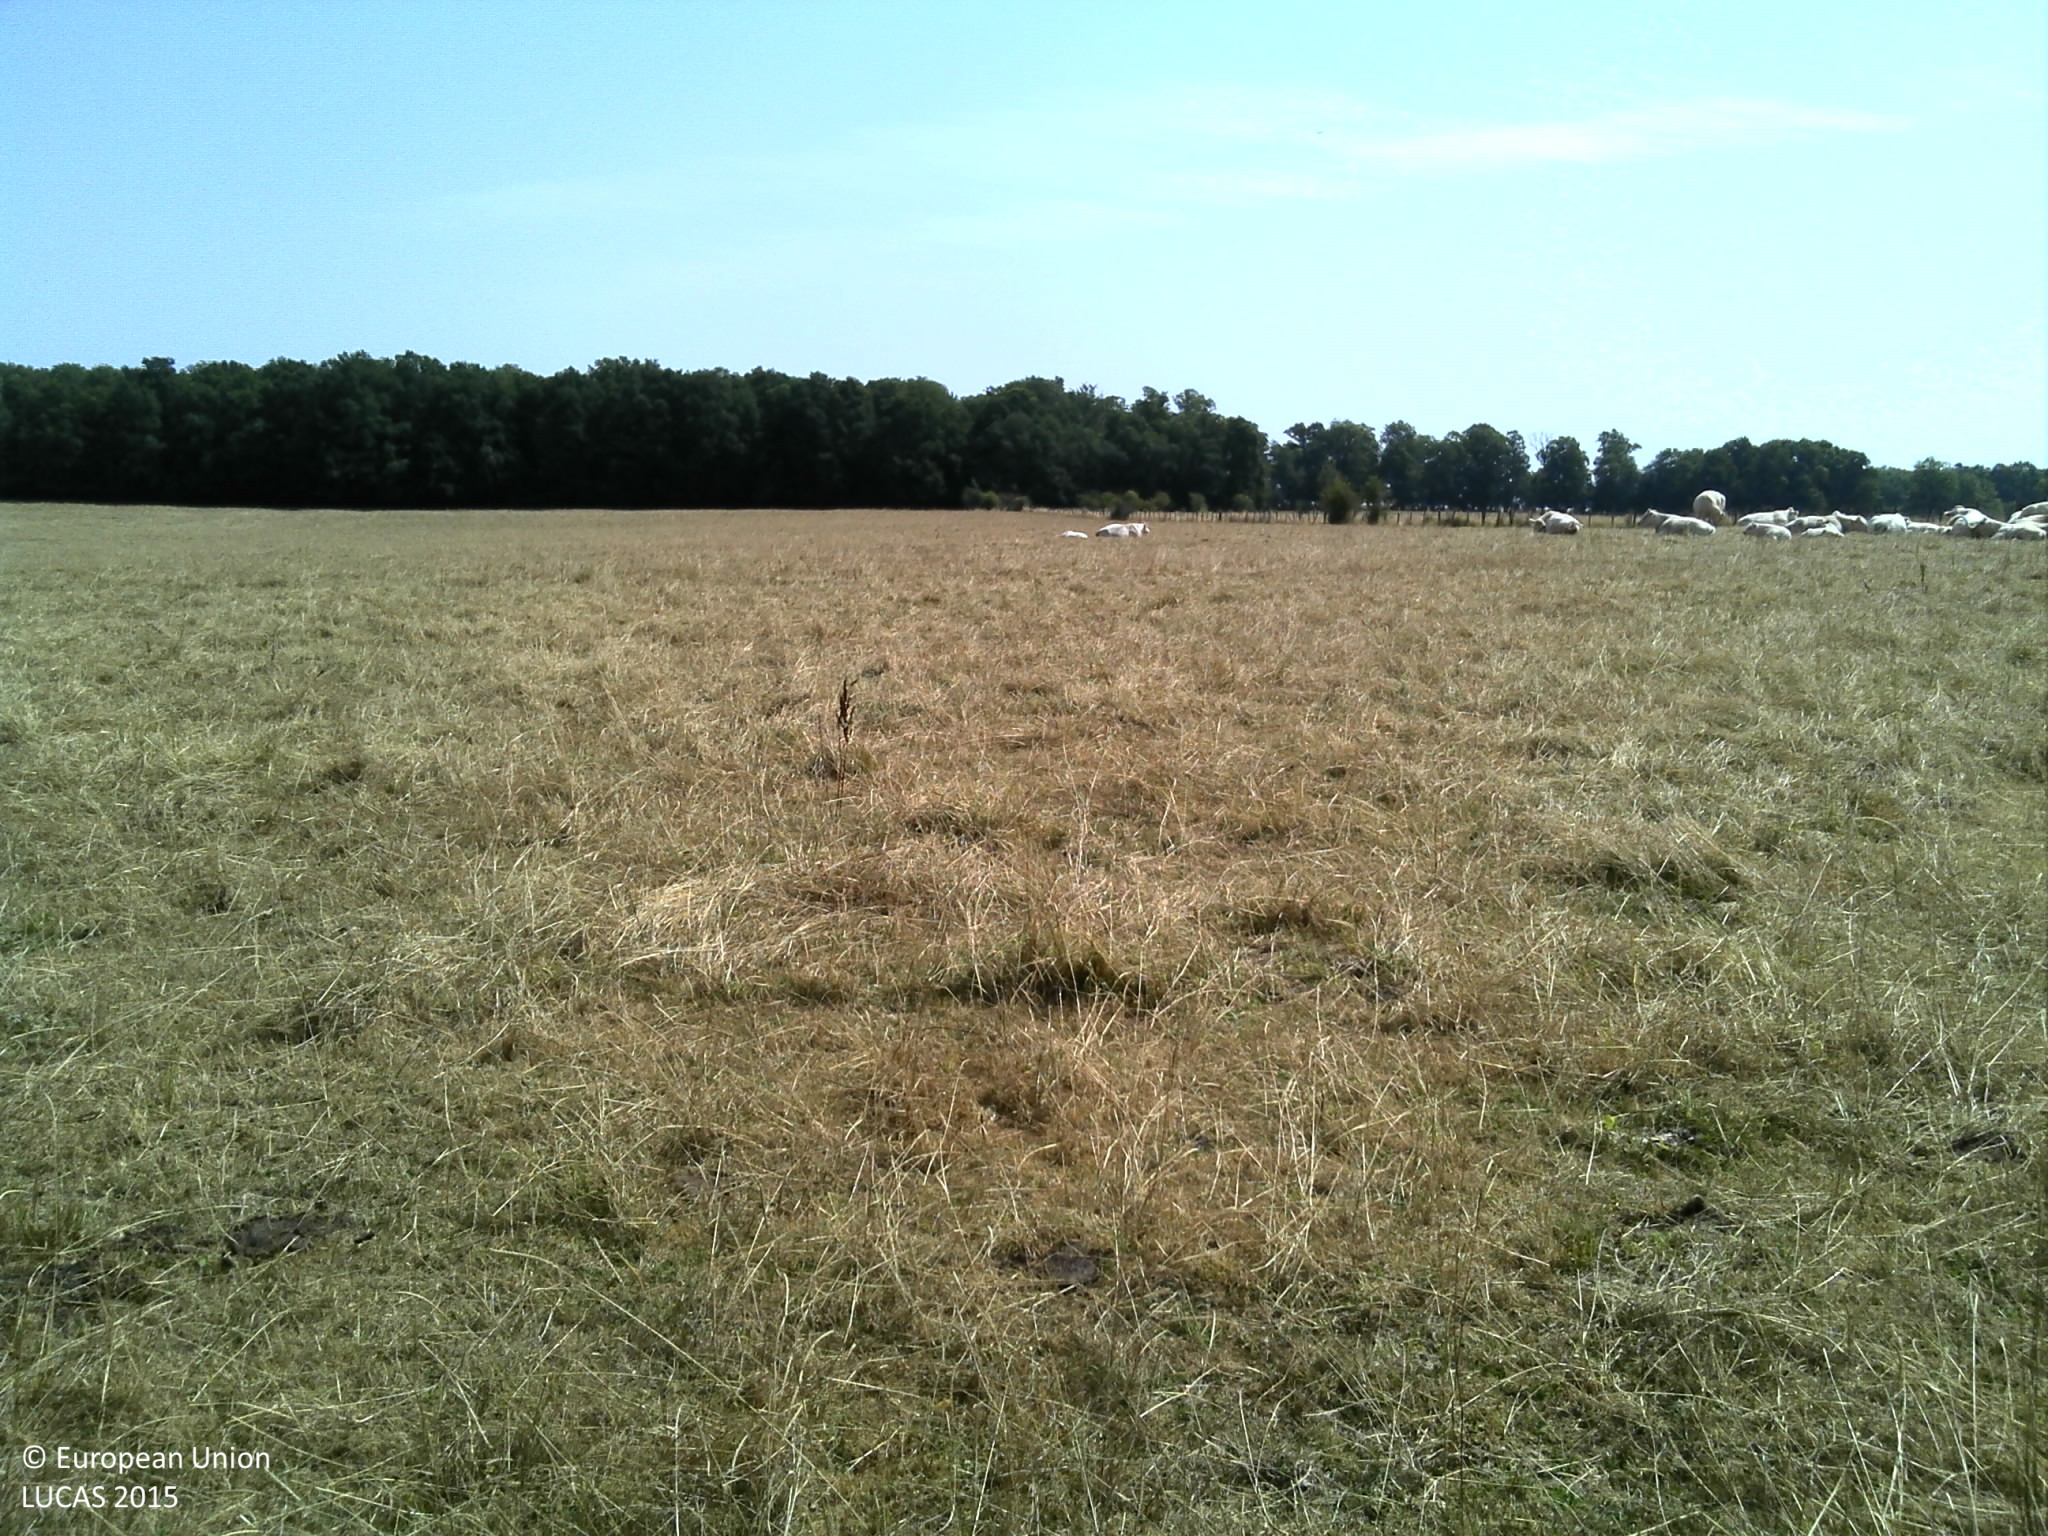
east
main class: Grassland
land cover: Grassland without tree/shrub cover
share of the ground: > 75 %
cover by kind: herbaceous plants 100 %
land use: Agriculture (excluding fallow land and kitchen gardens)
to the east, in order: Grassland without tree/shrub cover; Fences; Grassland without tree/shrub cover
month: July
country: FR
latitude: 48.8249
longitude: 4.8626
